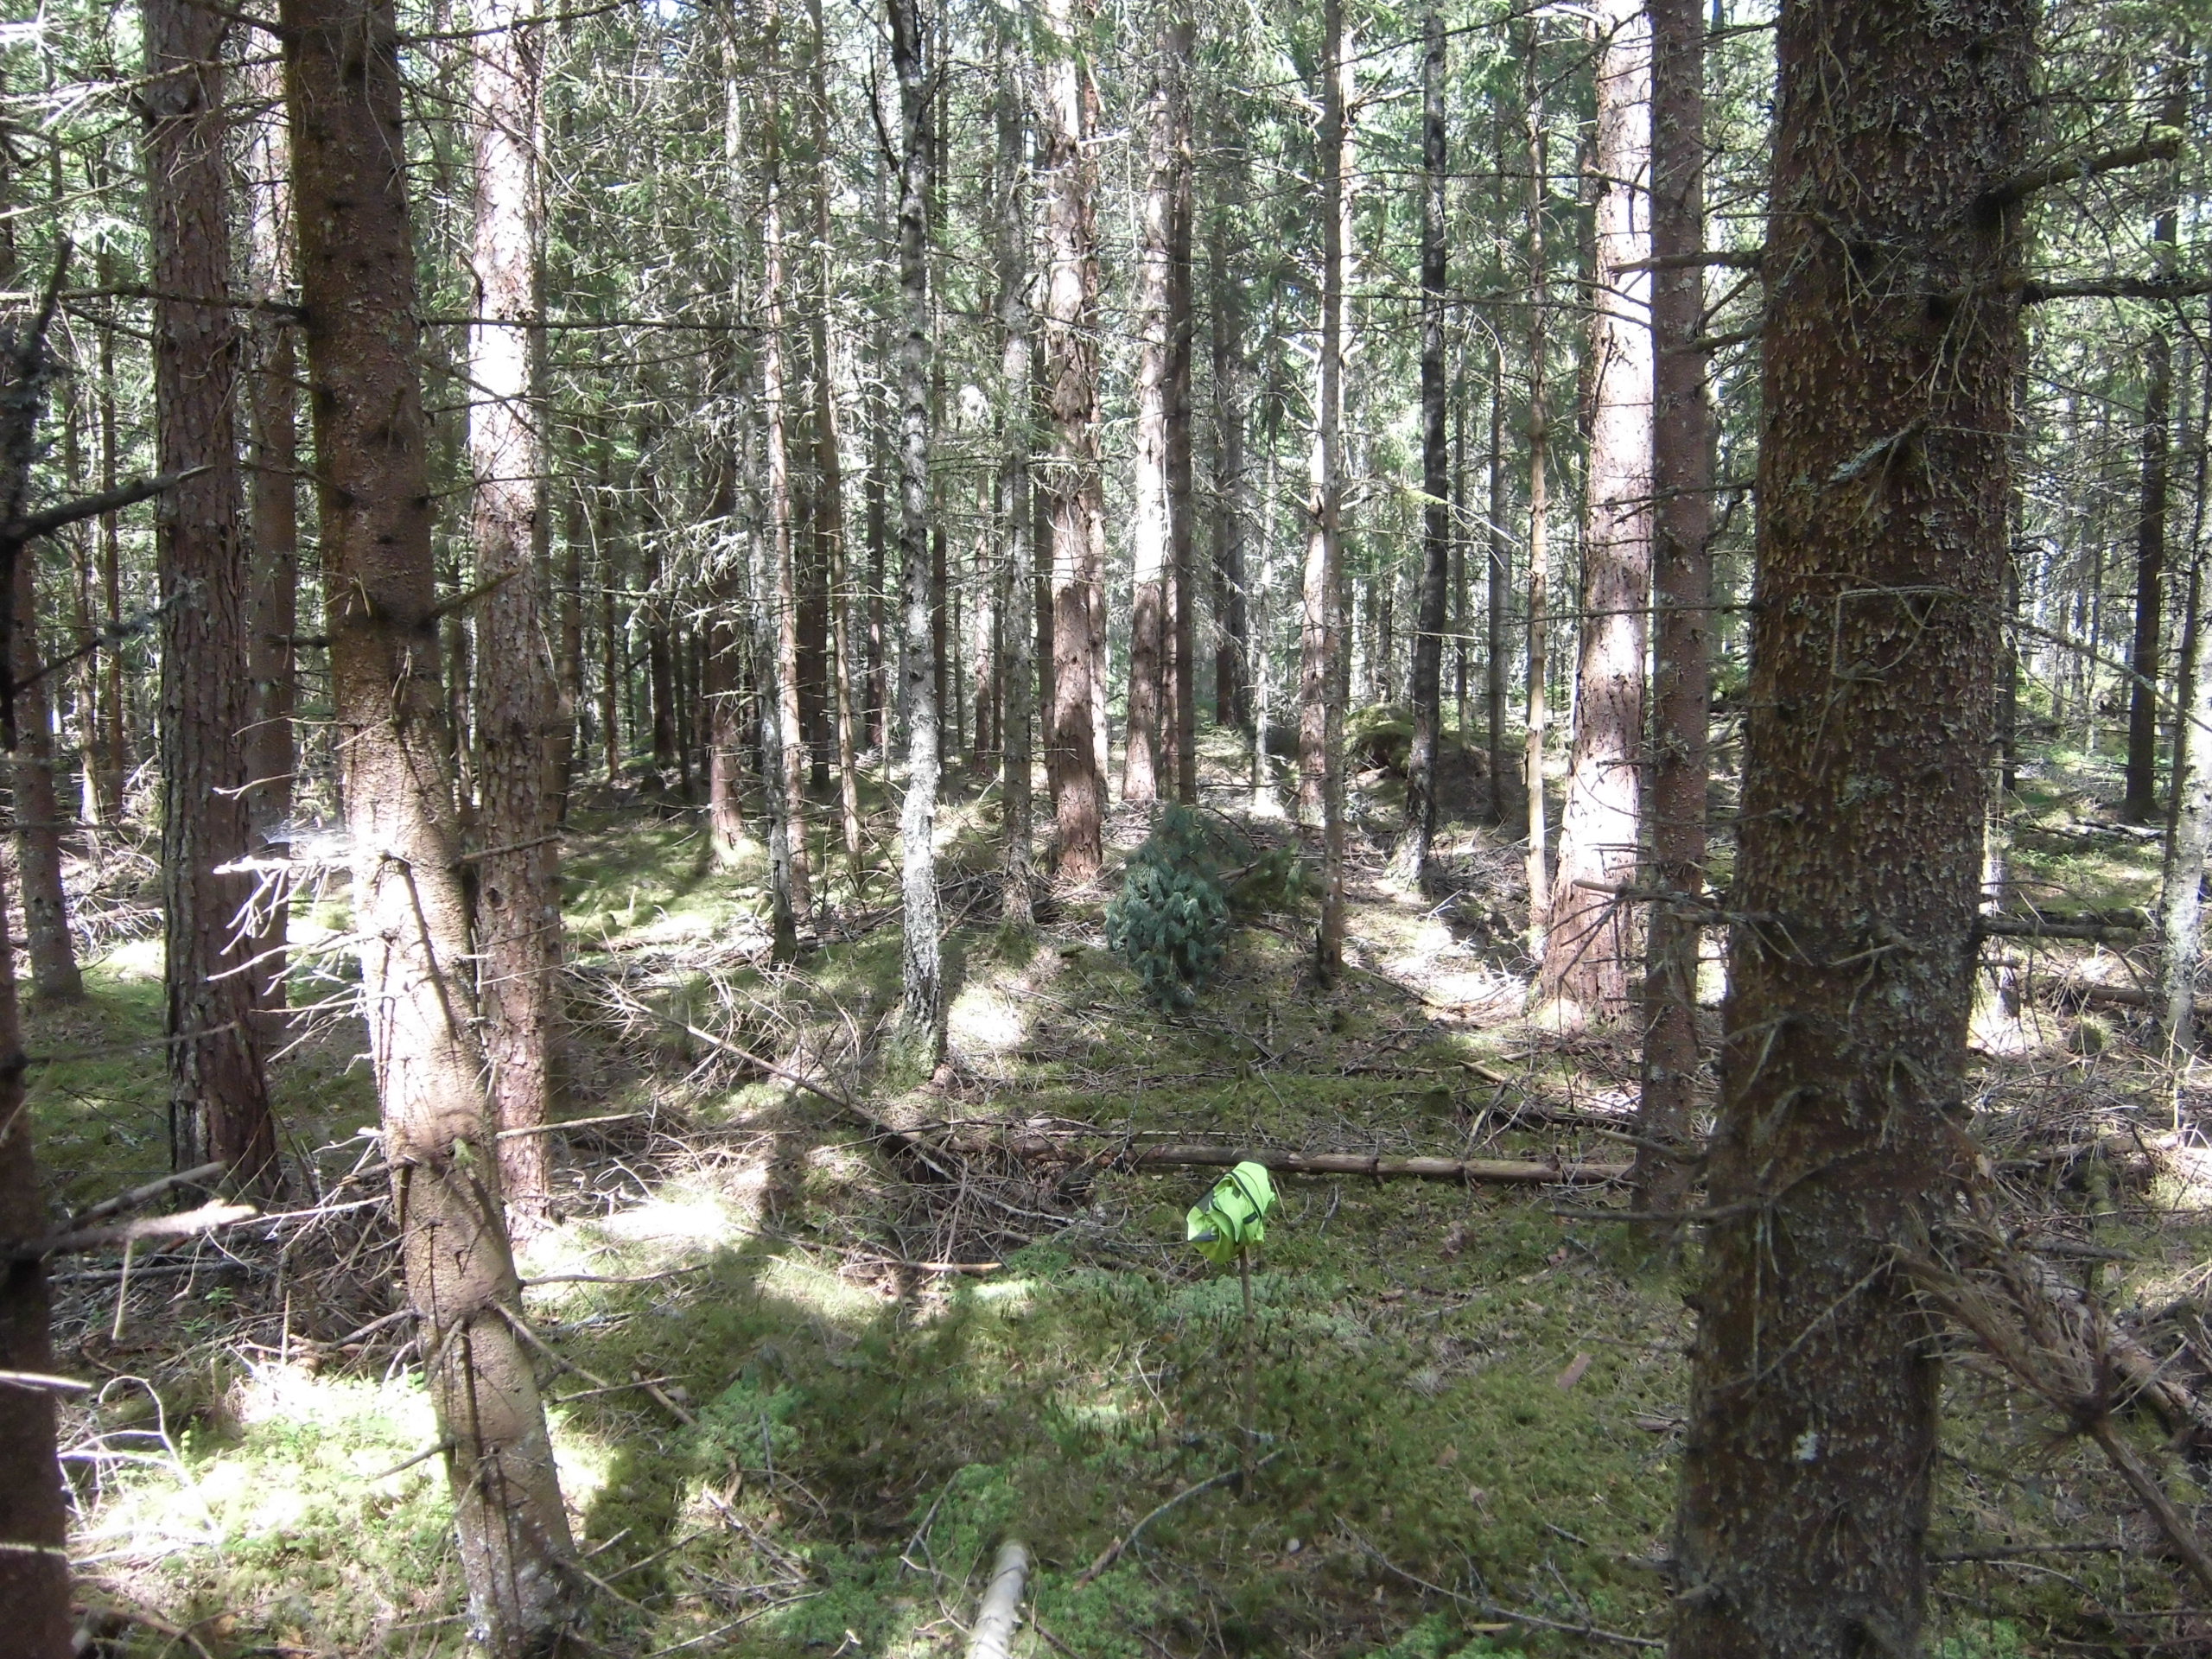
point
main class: Woodland
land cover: Pine dominated coniferous woodland
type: boreal forest
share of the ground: 50 - 75 %
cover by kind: coniferous forest trees 60 %, lichens and mosses 25 %, shrubs 10 %, herbaceous plants 5 %
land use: Forestry
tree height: > 5 m
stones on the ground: < 10 %
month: July
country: SE
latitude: 57.2915
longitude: 15.1571
